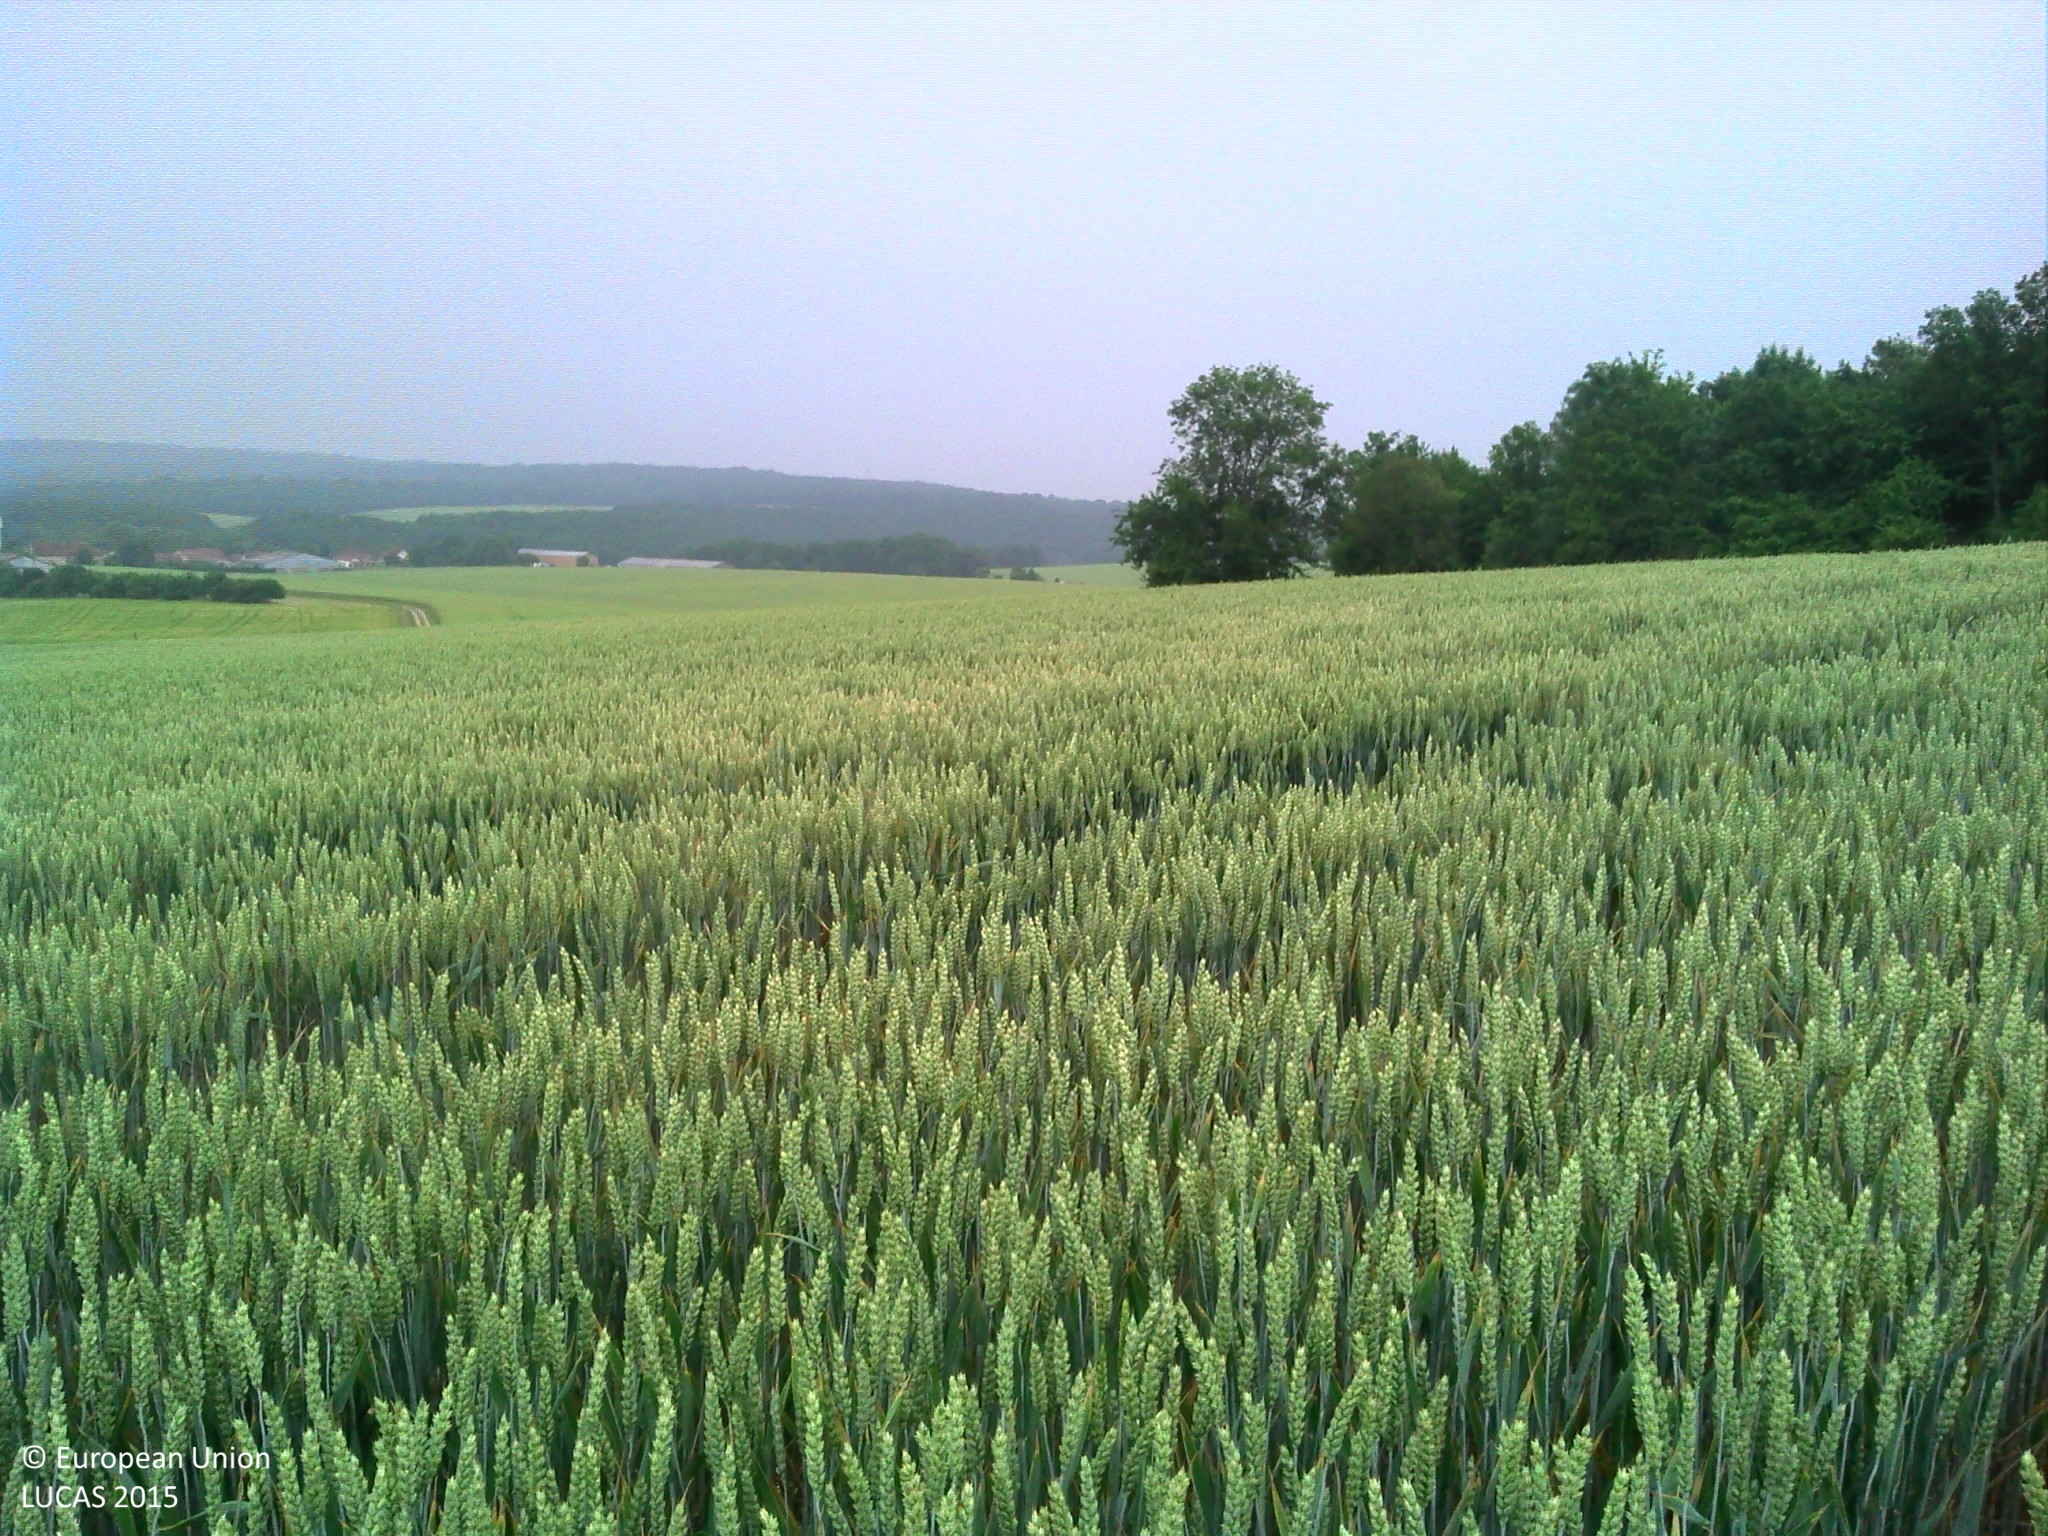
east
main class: Cropland
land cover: Common wheat
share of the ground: > 75 %
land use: Agriculture (excluding fallow land and kitchen gardens)
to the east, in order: Common wheat; Fences; Rye; Fences; Grass margins; Tracks; Grass margins; Rape and turnip rape
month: June
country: FR
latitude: 48.1982
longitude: 4.9535
